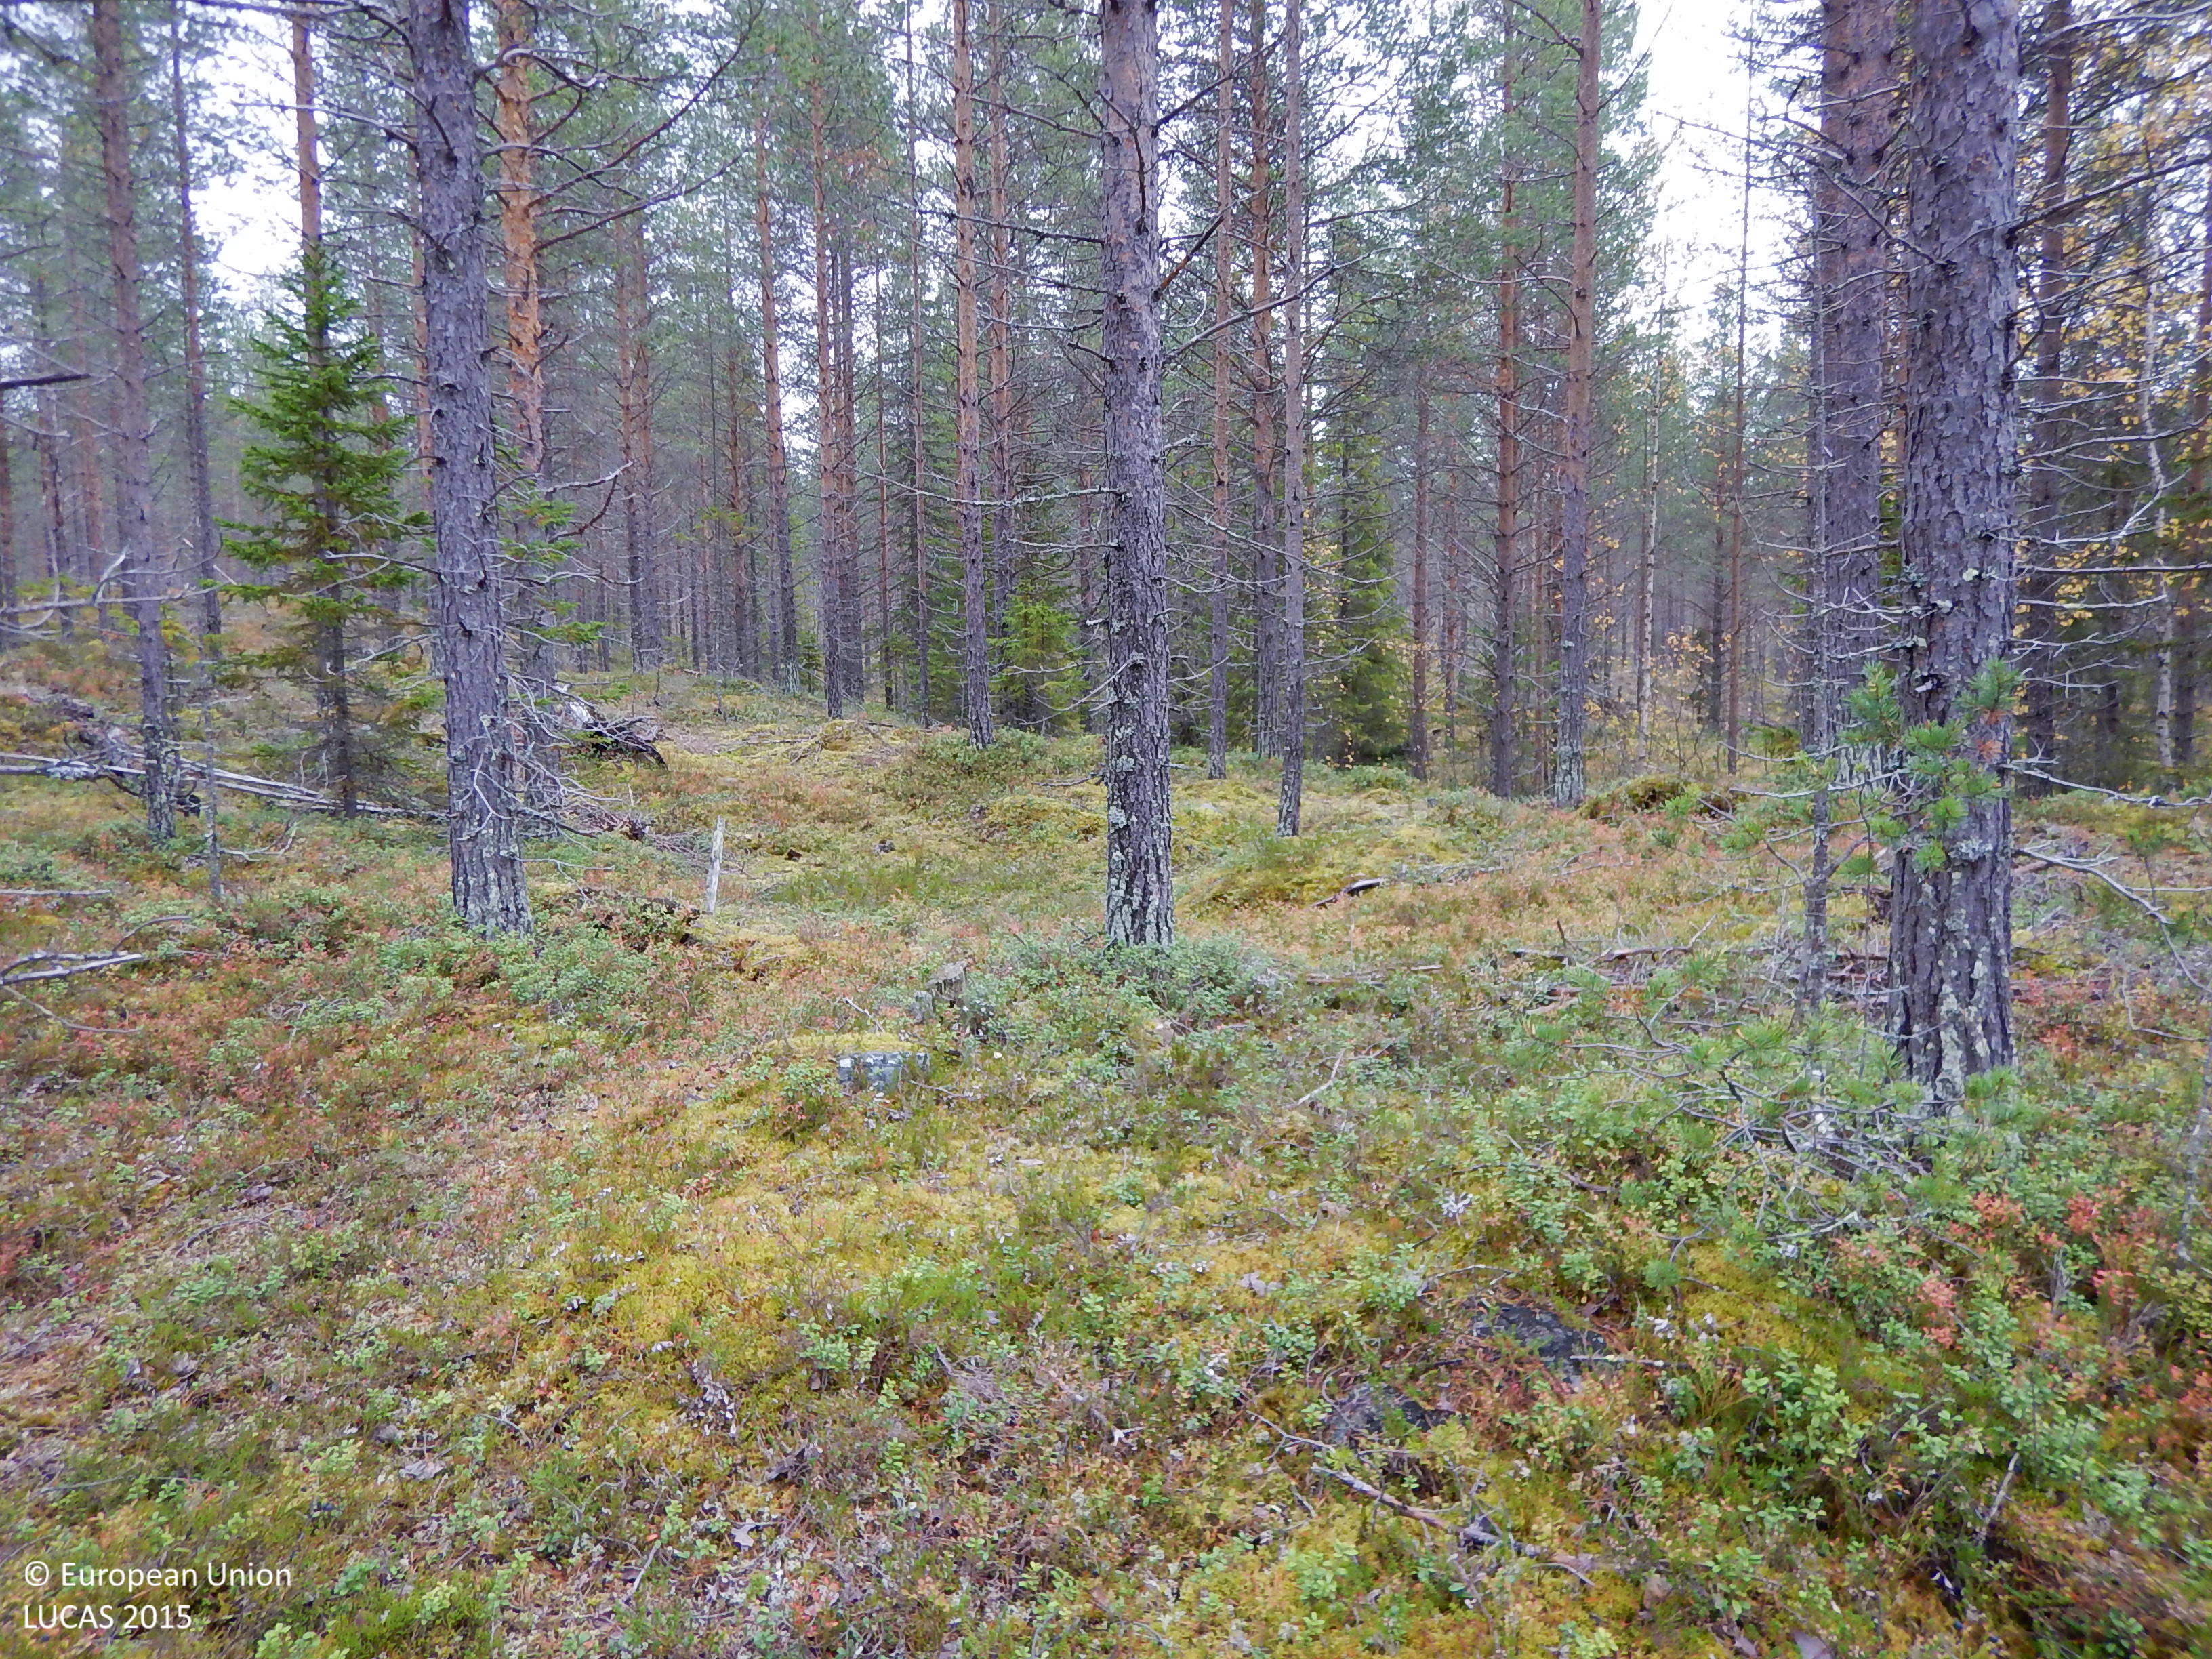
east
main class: Woodland
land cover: Pine dominated coniferous woodland
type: boreal forest
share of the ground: 50 - 75 %
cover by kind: coniferous forest trees 65 %, shrubs 15 %, lichens and mosses 15 %, herbaceous plants 5 %
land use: Forestry
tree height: > 5 m
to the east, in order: Pine dominated coniferous woodland
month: September
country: SE
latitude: 65.0743
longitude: 19.2586
